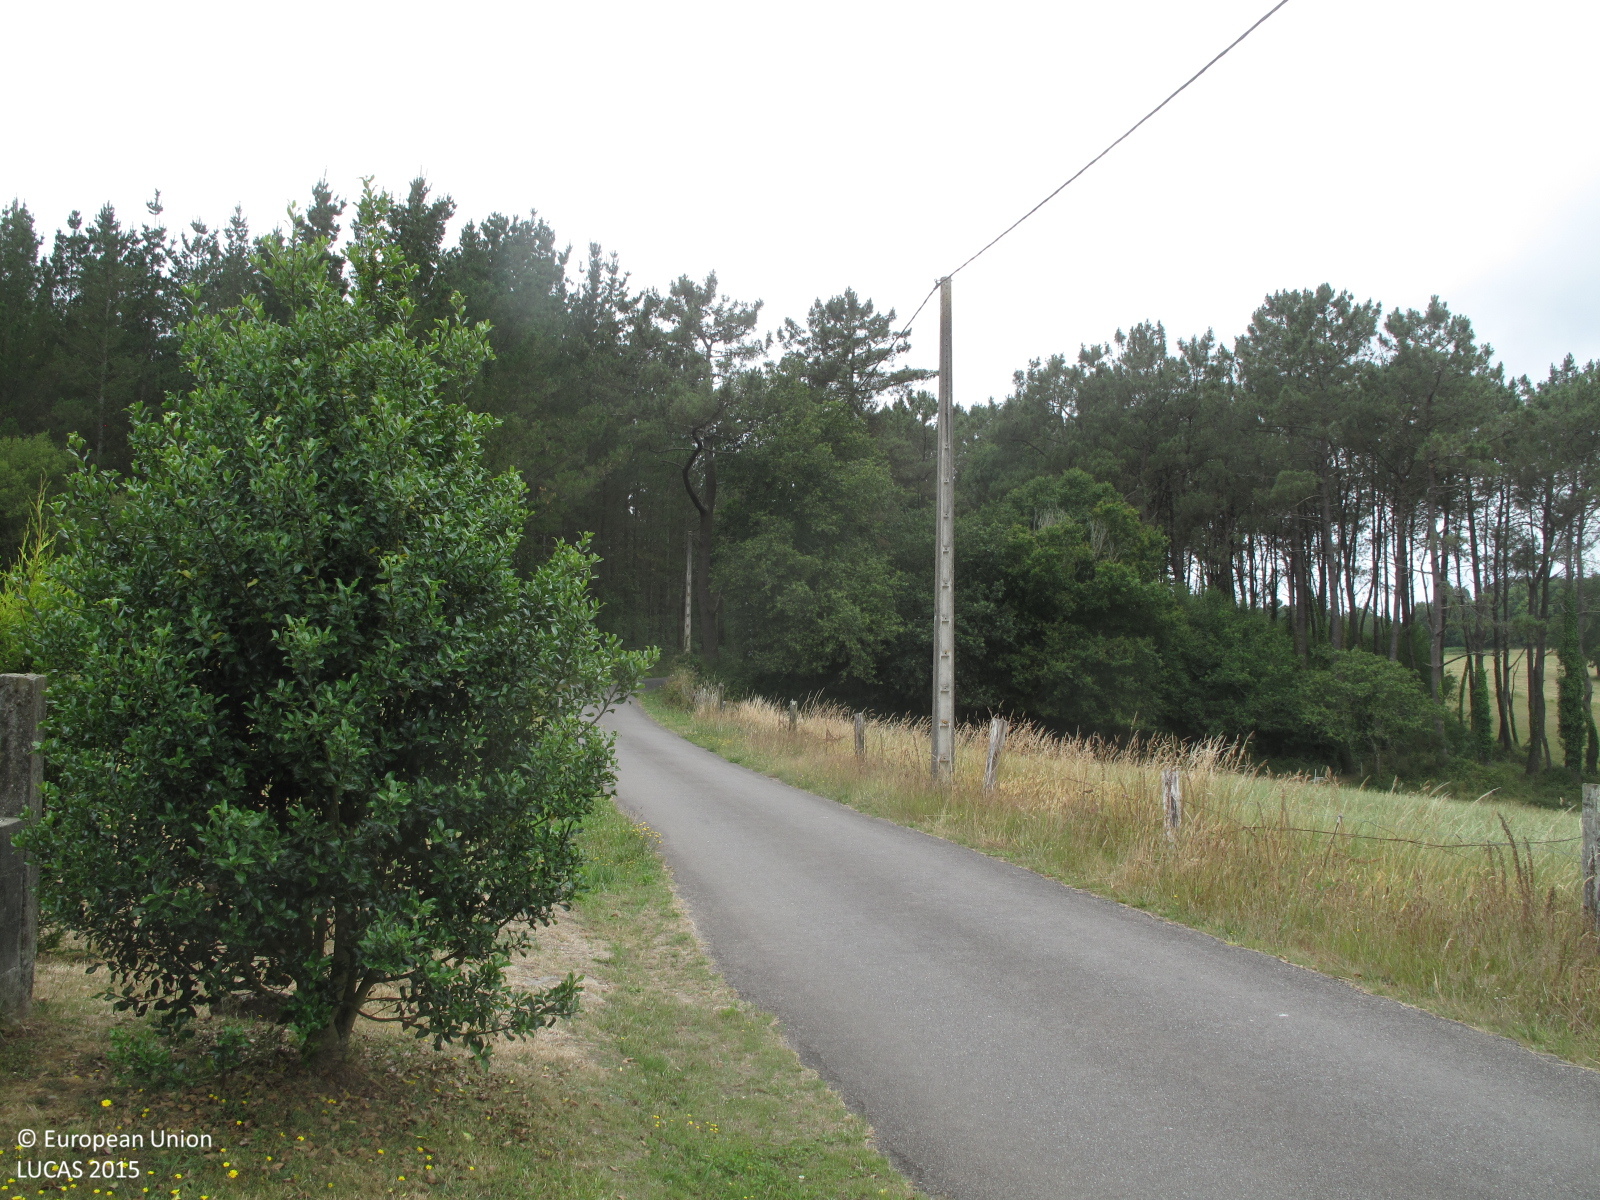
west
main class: Grassland
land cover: Grassland with sparse tree/shrub cover
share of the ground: > 75 %
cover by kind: herbaceous plants 90 %, broadleaved forest trees 5 %, shrubs 5 %
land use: Residential
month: July
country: ES
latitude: 43.4520
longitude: -8.0528
